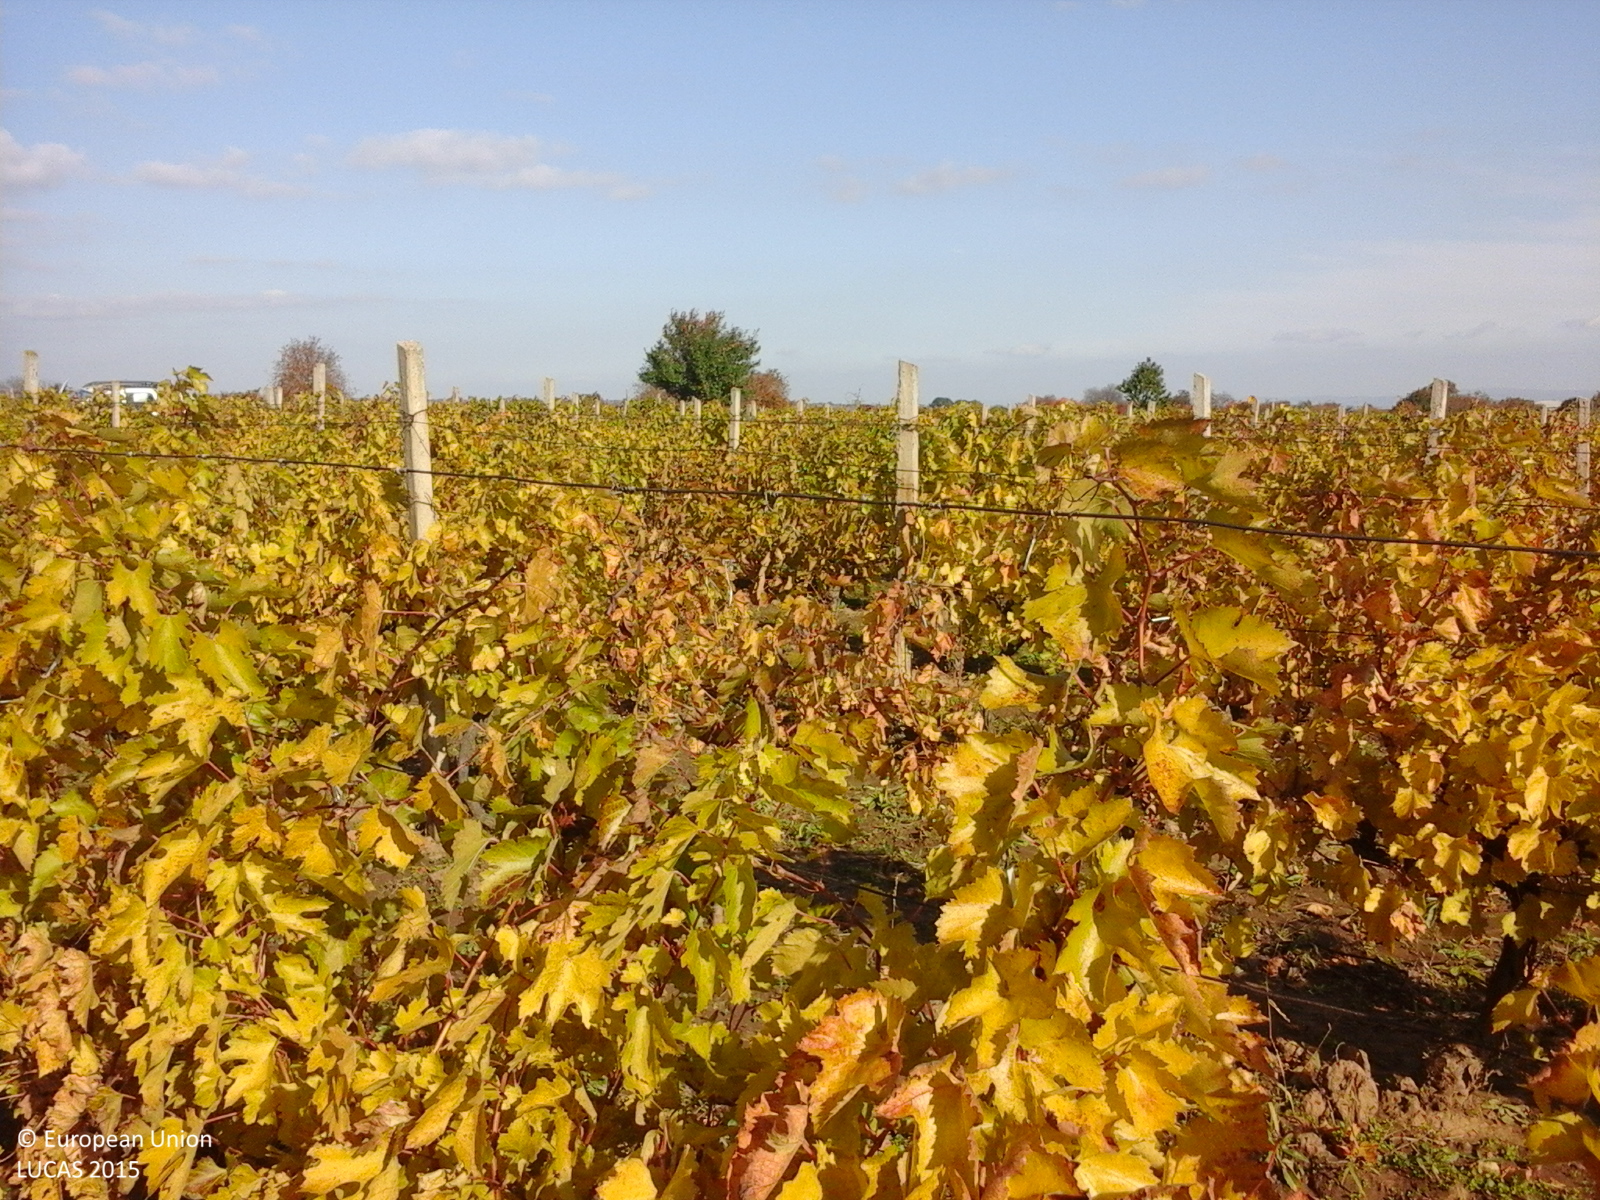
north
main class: Cropland
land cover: Vineyards
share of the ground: > 75 %
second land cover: Grassland without tree/shrub cover
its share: 25 - 50 %
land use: Agriculture (excluding fallow land and kitchen gardens)
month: October
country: RO
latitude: 45.9740
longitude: 27.0922
